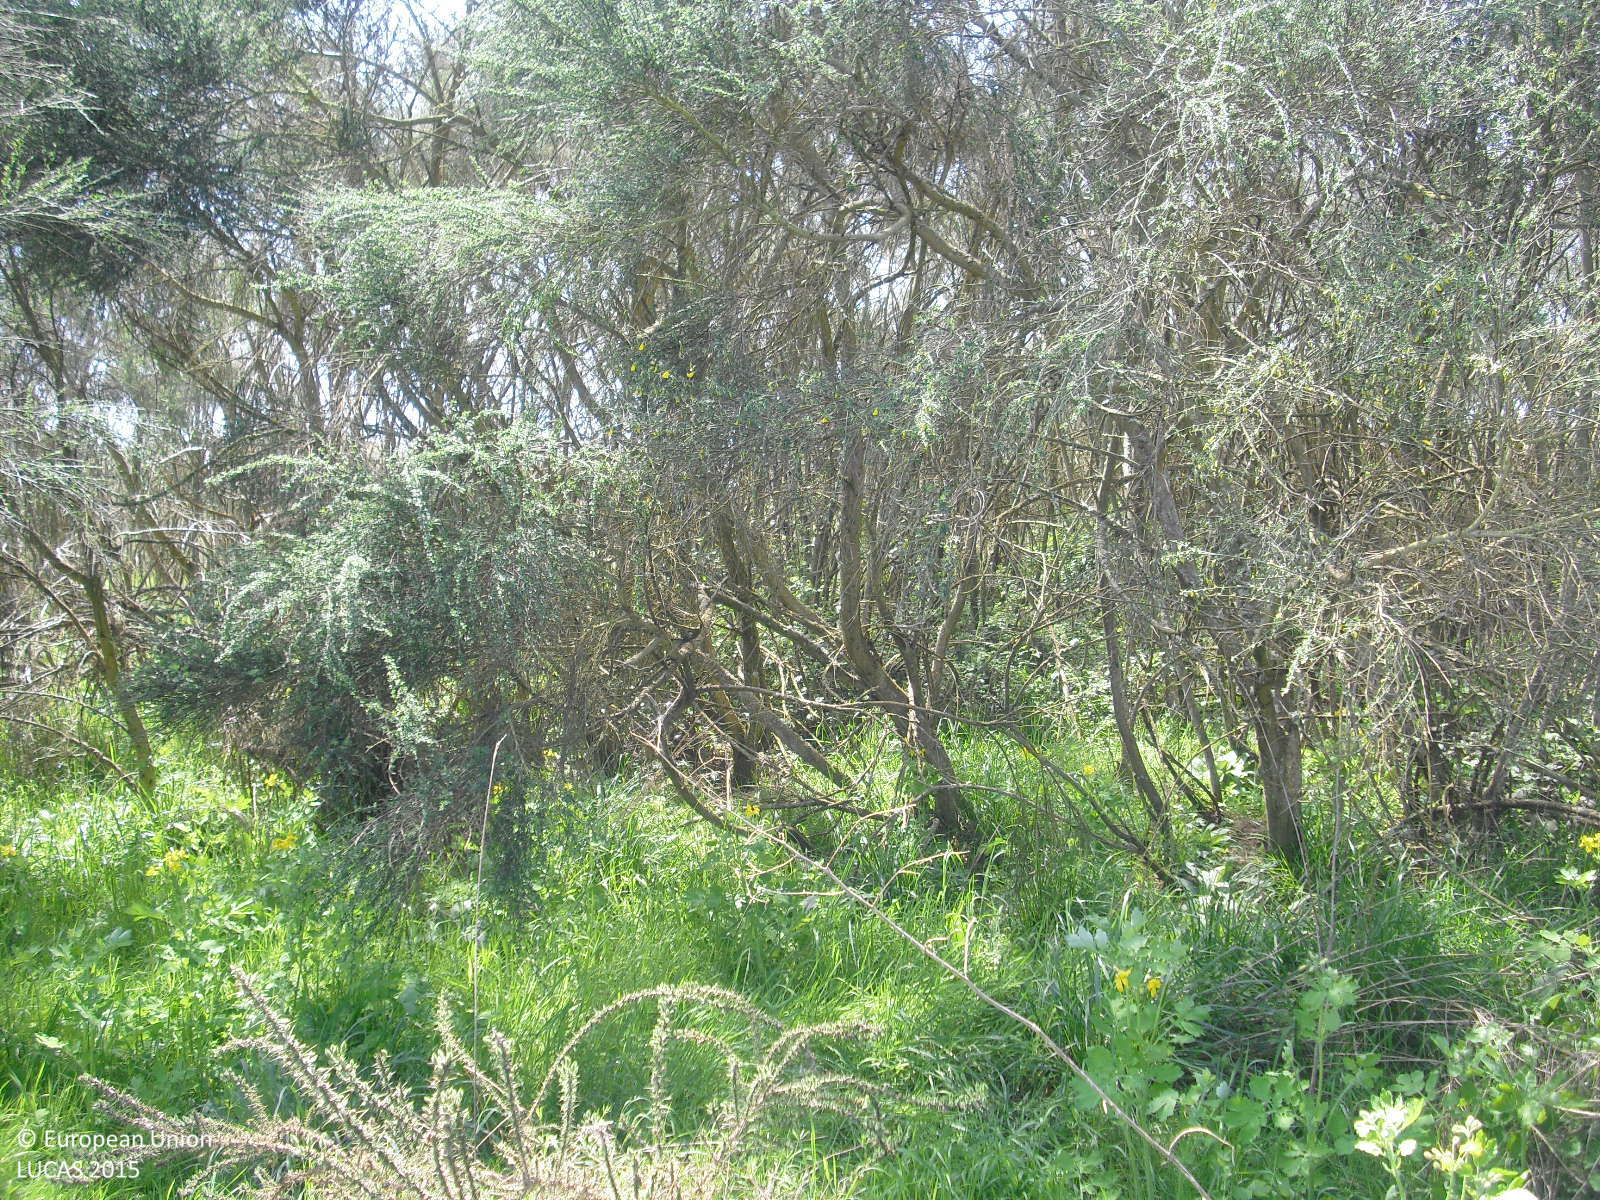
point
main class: Shrubland
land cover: Shrubland without tree cover
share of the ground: > 75 %
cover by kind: shrubs 90 %, herbaceous plants 10 %
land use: Abandoned areas
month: April
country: ES
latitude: 42.0582
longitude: -7.6989
